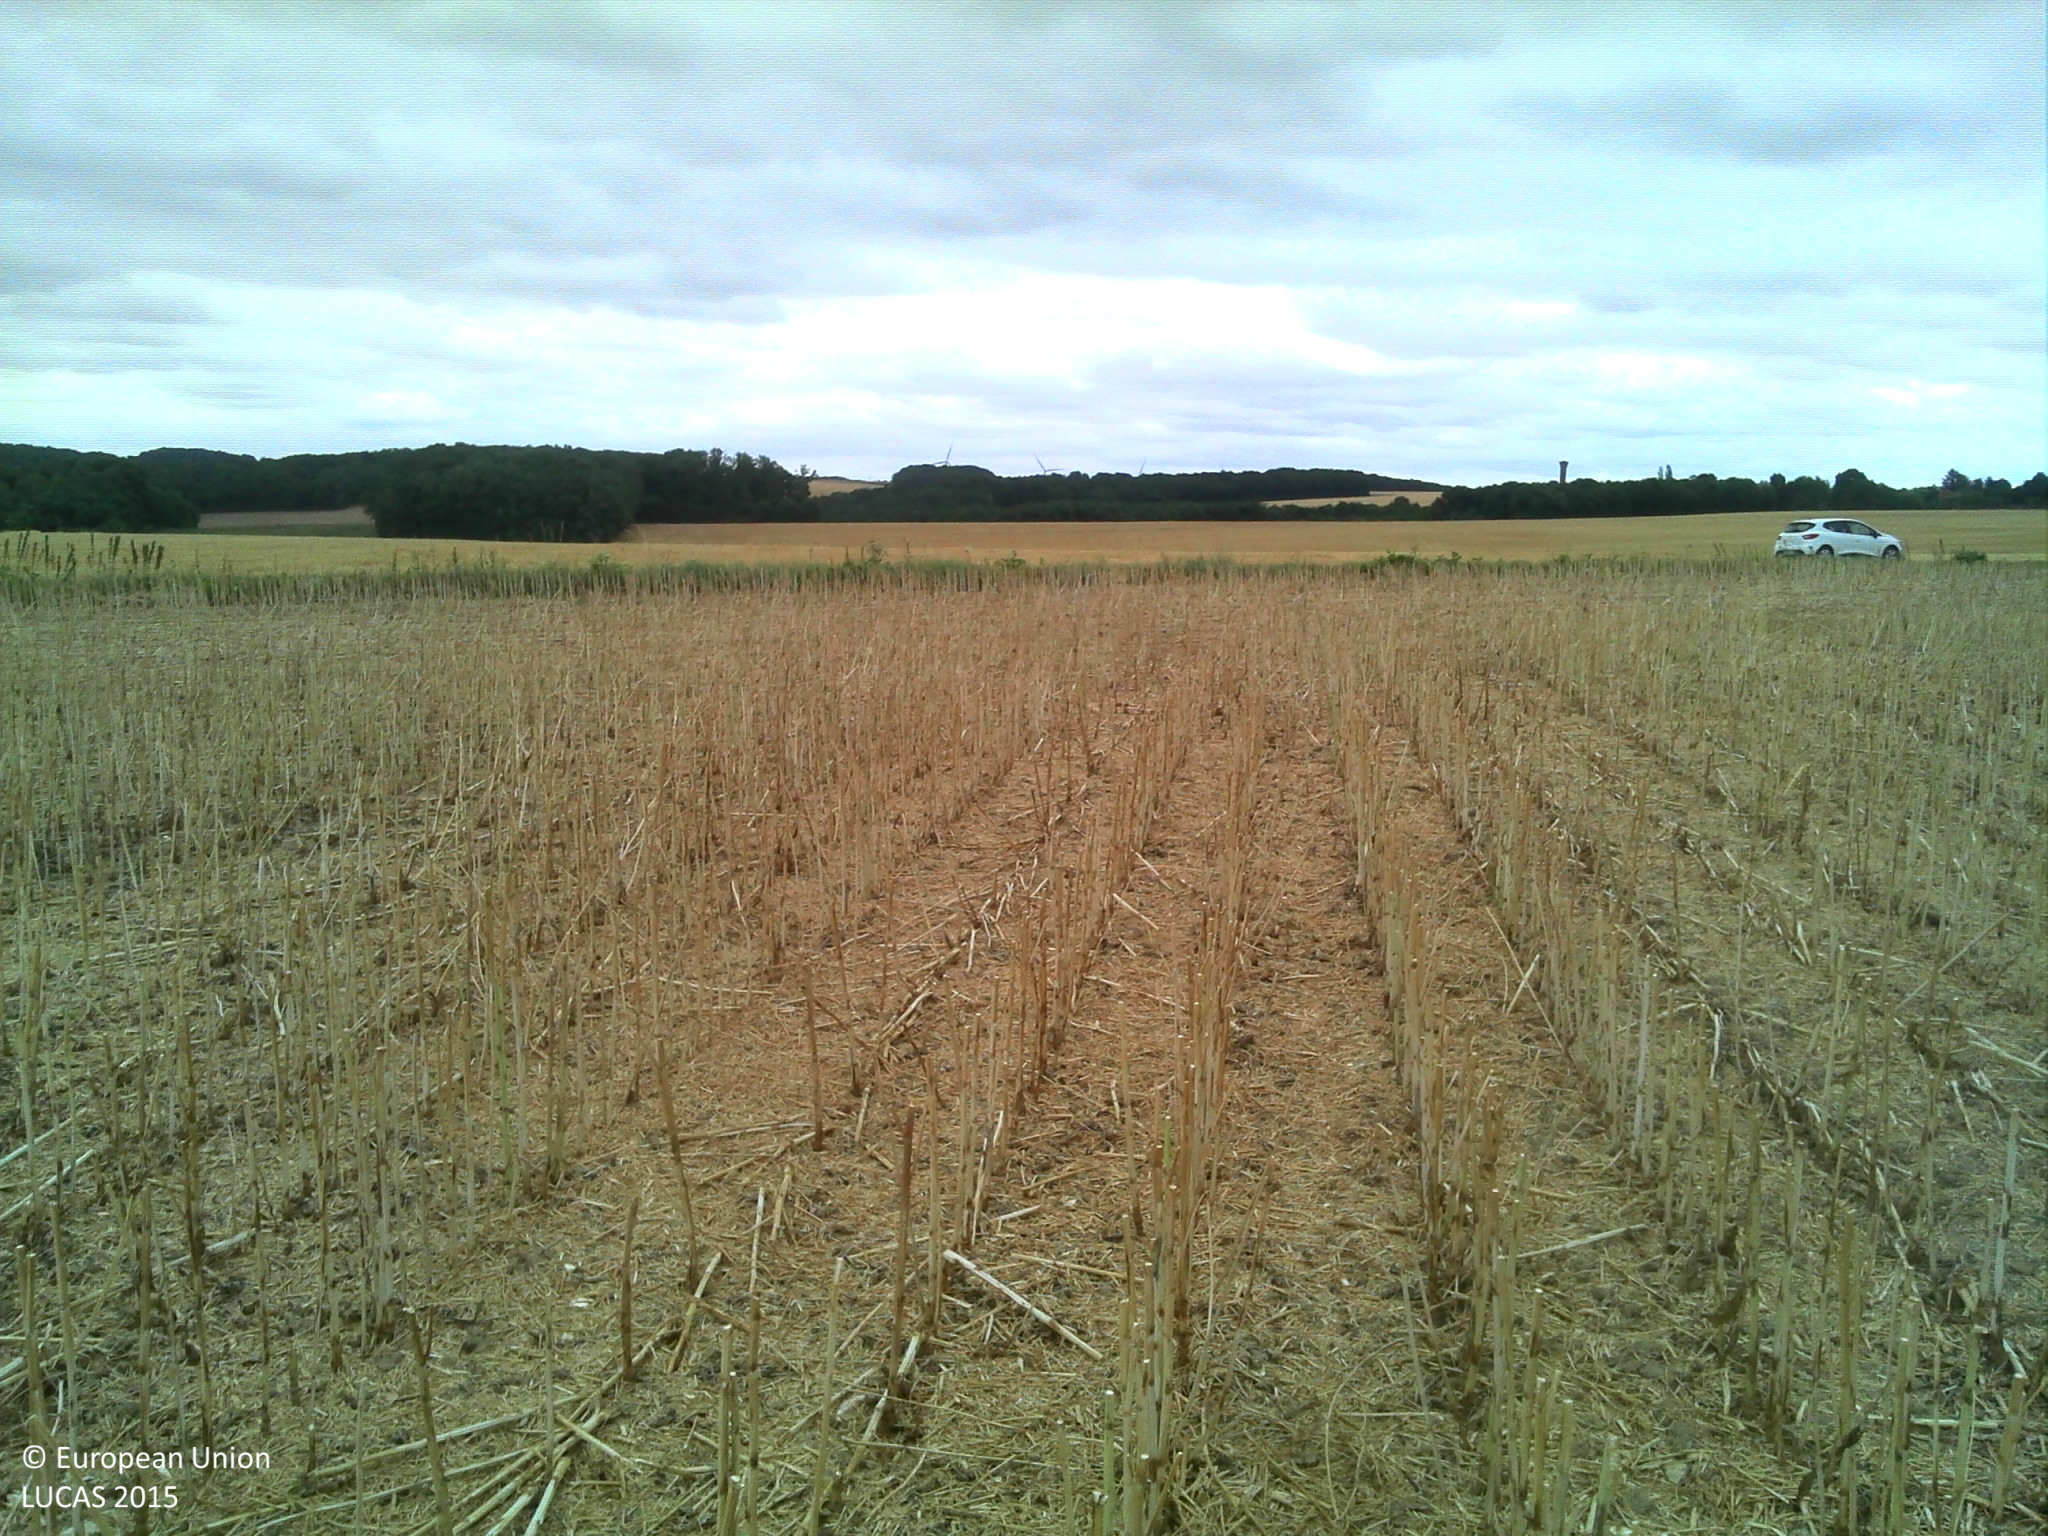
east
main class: Cropland
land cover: Rape and turnip rape
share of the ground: > 75 %
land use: Agriculture (excluding fallow land and kitchen gardens)
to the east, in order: Rape and turnip rape; Grass margins; Ditches and canals; Grass margins; Paved roads, cycling and walking lanes; Grass margins; Ditches and canals; Grass margins; Barley
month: July
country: FR
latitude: 48.2055
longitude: 3.3872
